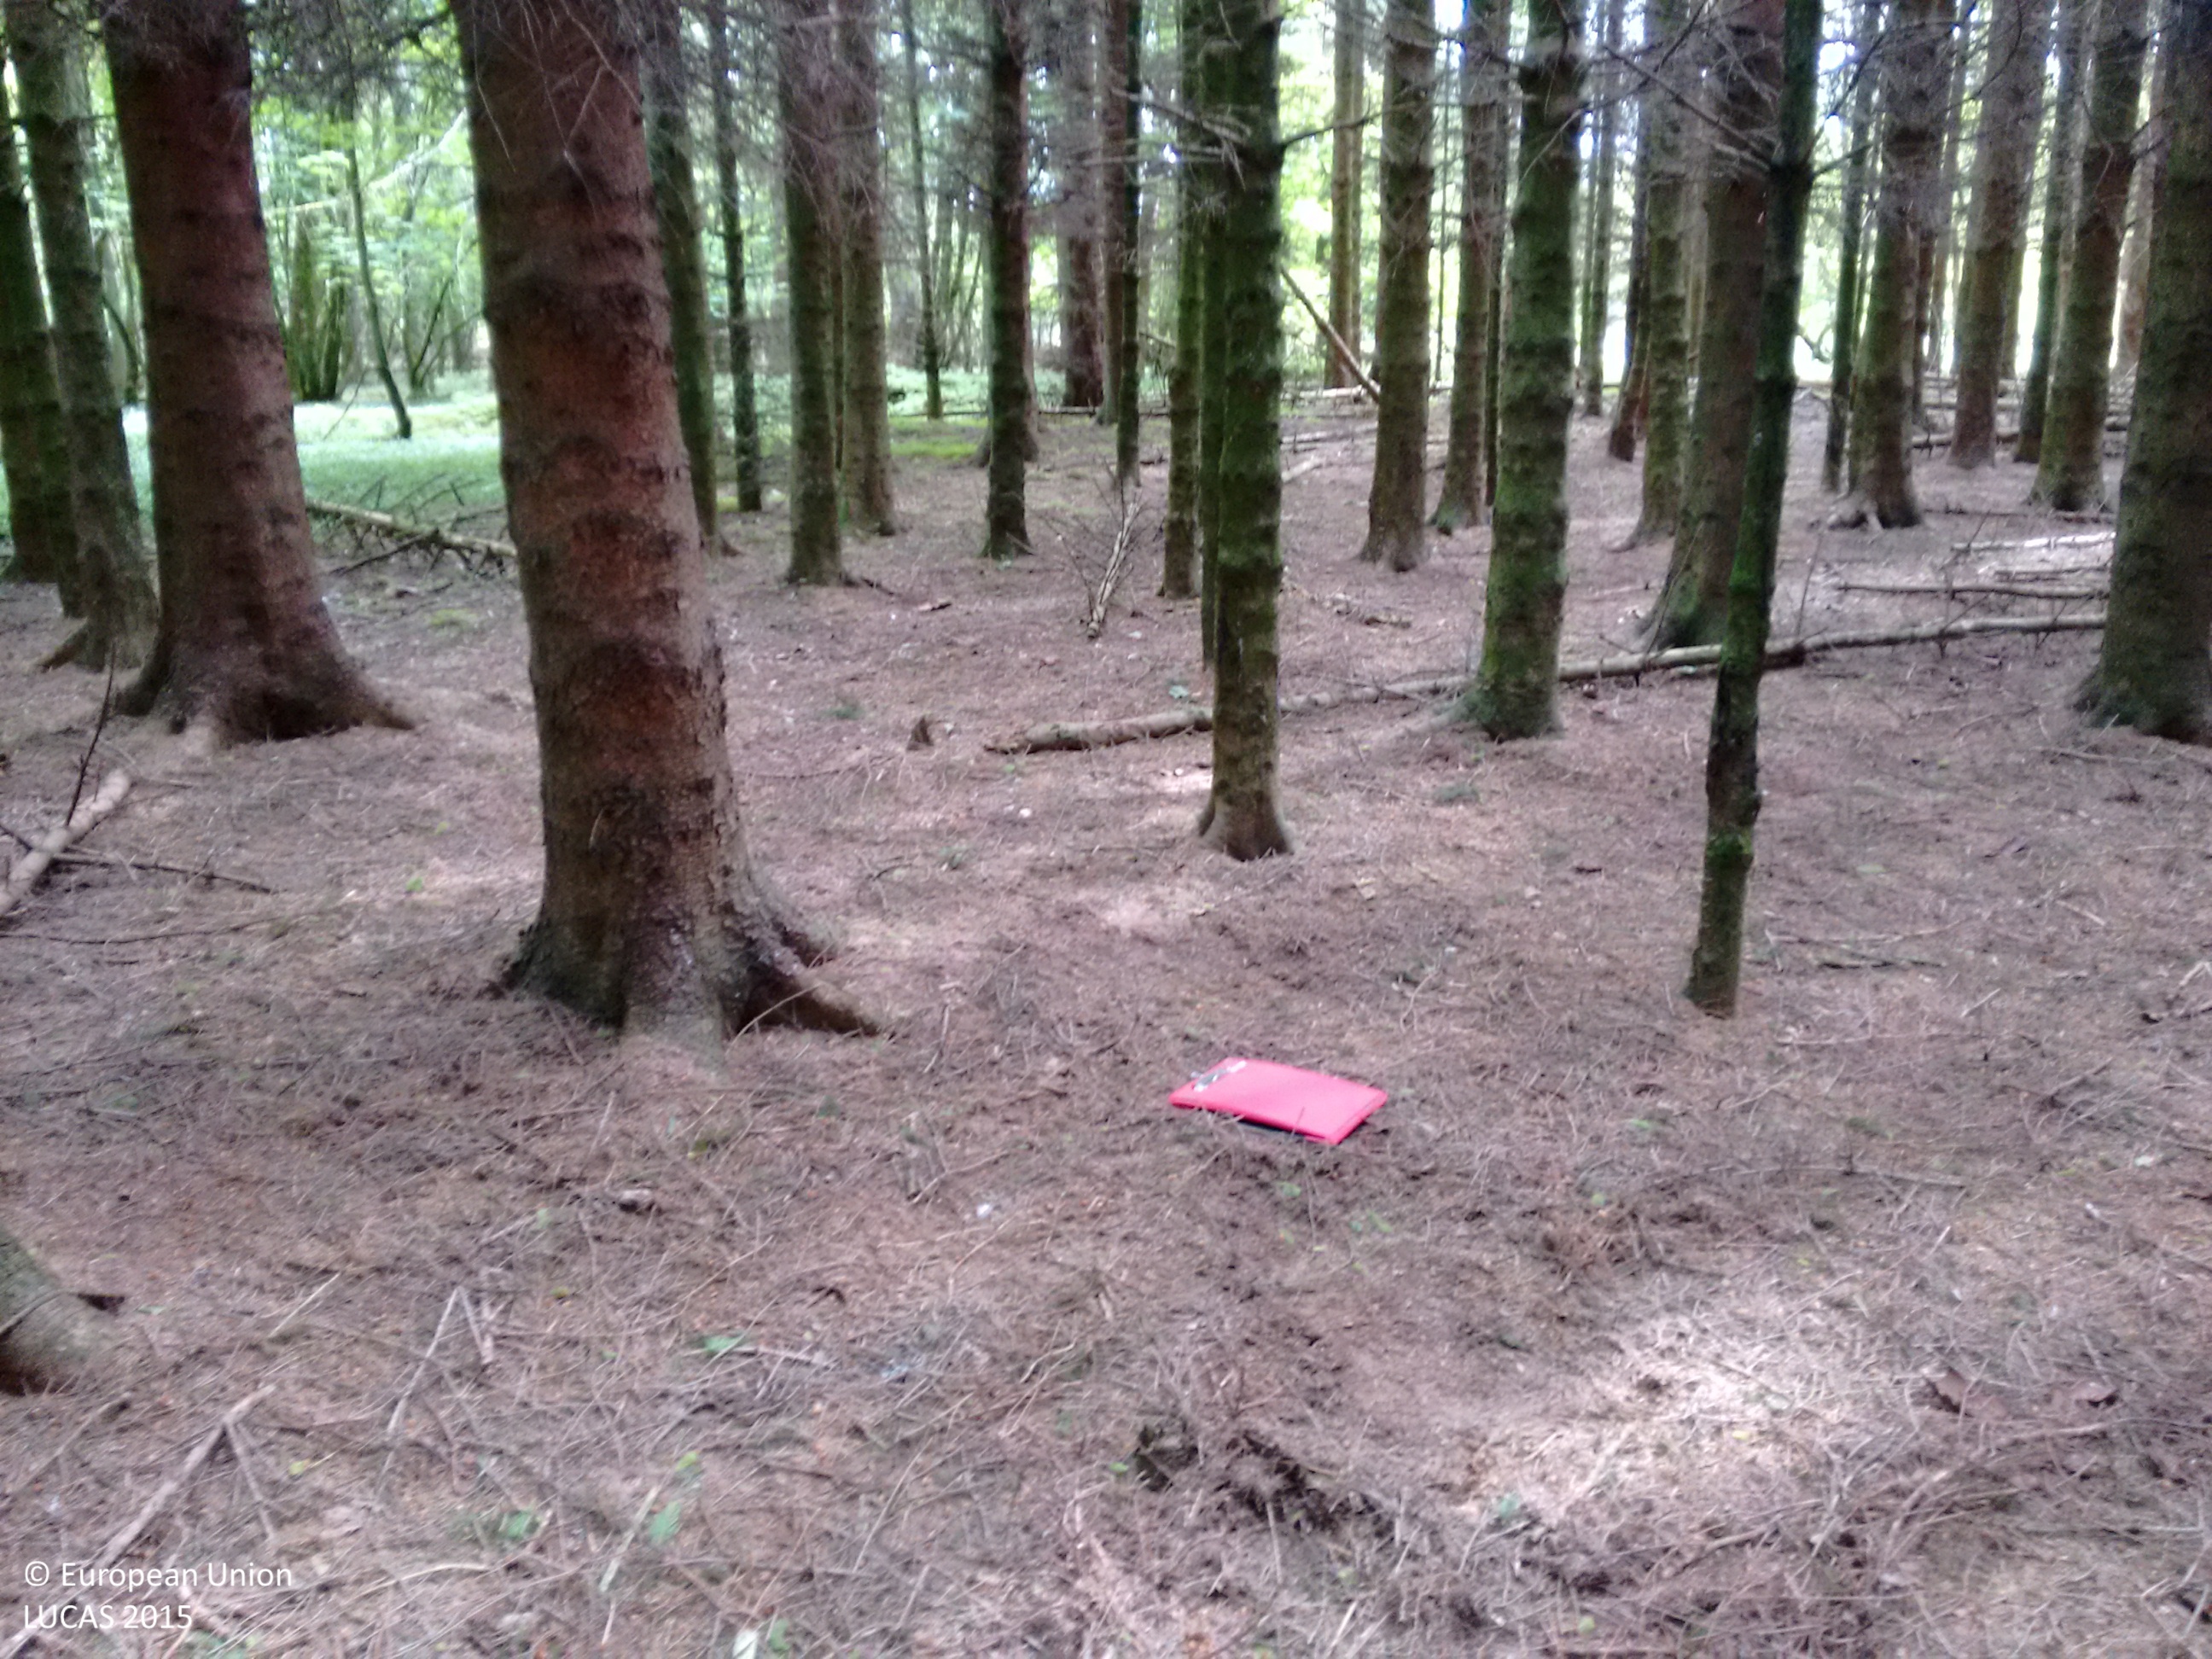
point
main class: Woodland
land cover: Pine dominated coniferous woodland
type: exotic forest
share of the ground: > 75 %
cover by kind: coniferous forest trees 95 %, broadleaved forest trees 5 %
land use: Forestry
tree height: > 5 m
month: June
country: GB
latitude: 56.2101
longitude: -3.4078
